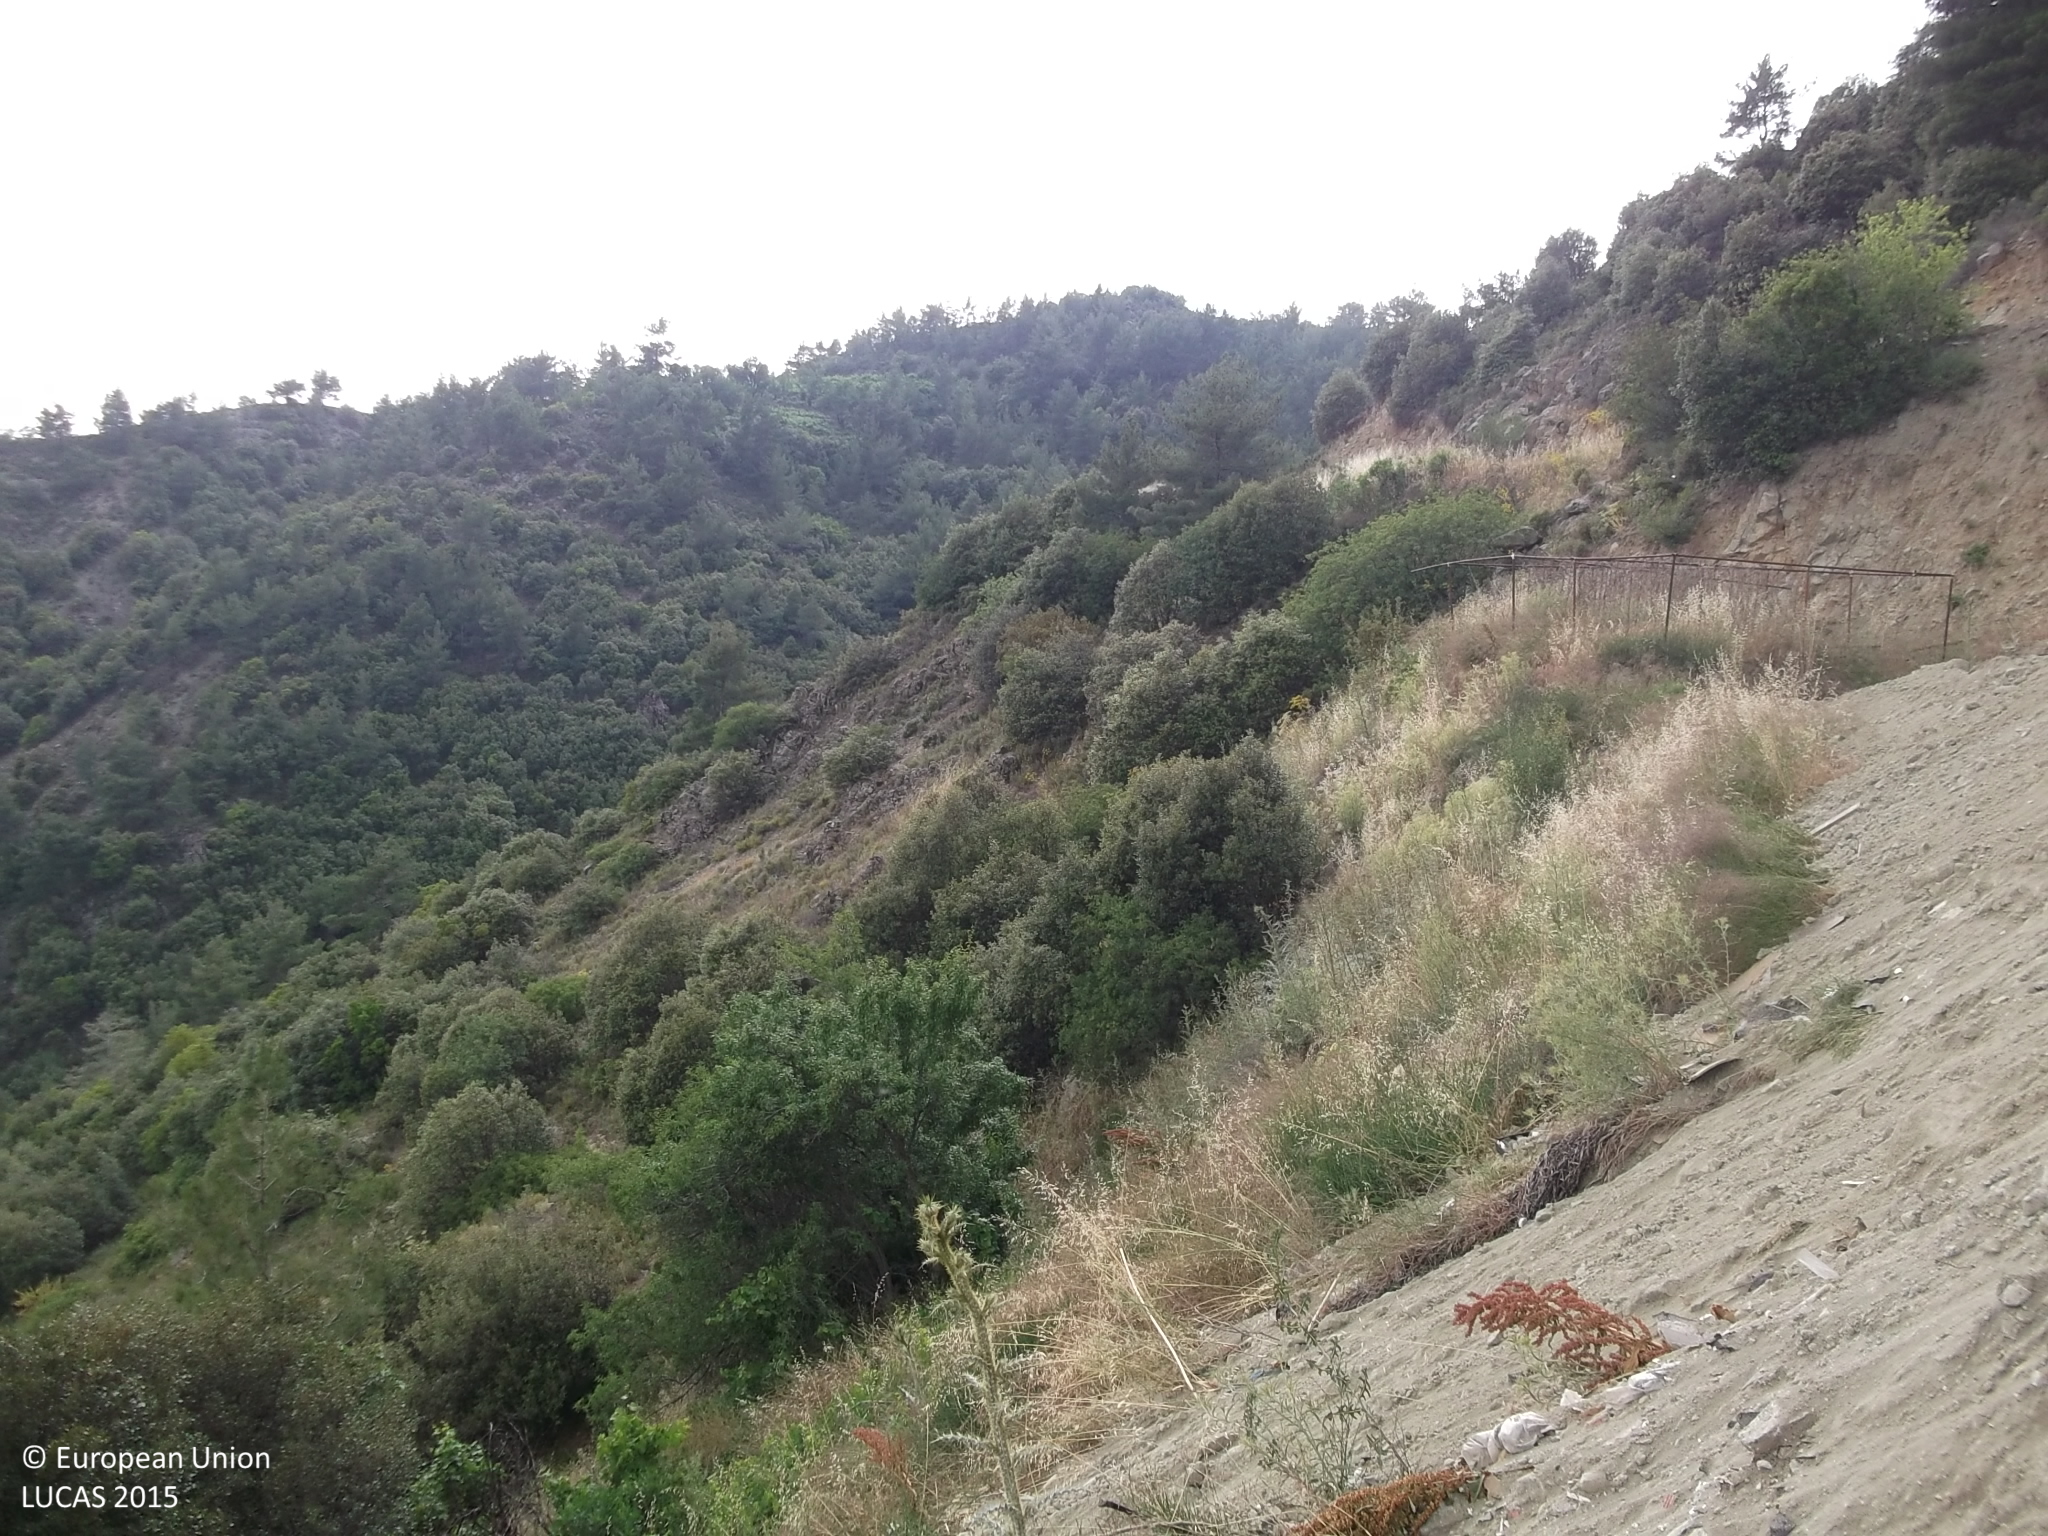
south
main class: Woodland
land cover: Broadleaved woodland
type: broadleaved evergreen forest
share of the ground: 10 - 25 %
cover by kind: shrubs 35 %, broadleaved forest trees 20 %, unconsolidated bare surface 20 %, herbaceous plants 15 %, coniferous forest trees 5 %, consolidated bare surface 5 %
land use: Semi-natural and natural areas not in use
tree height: > 5 m
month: June
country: CY
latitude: 34.9317
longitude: 32.9746
